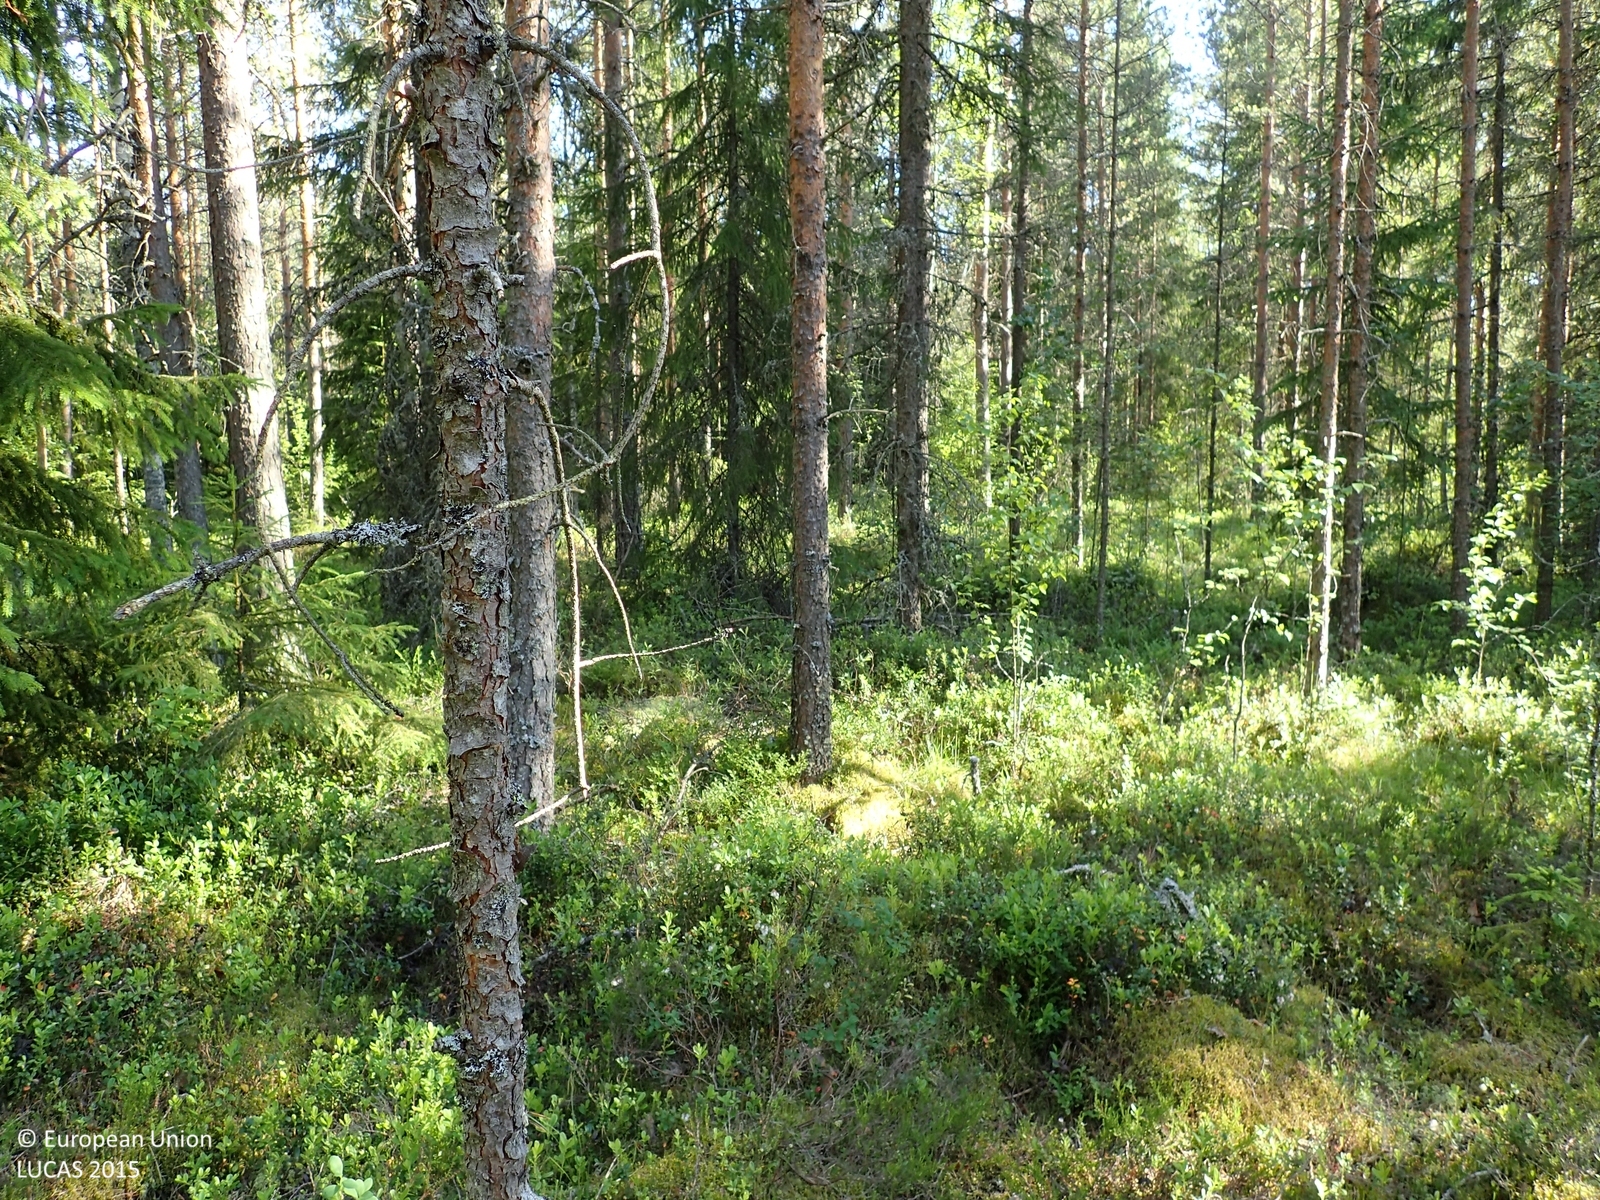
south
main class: Woodland
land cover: Pine dominated coniferous woodland
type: boreal forest
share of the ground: 50 - 75 %
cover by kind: coniferous forest trees 50 %, shrubs 45 %, broadleaved forest trees 5 %
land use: Forestry
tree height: > 5 m
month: July
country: FI
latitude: 62.7046
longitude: 21.6739
